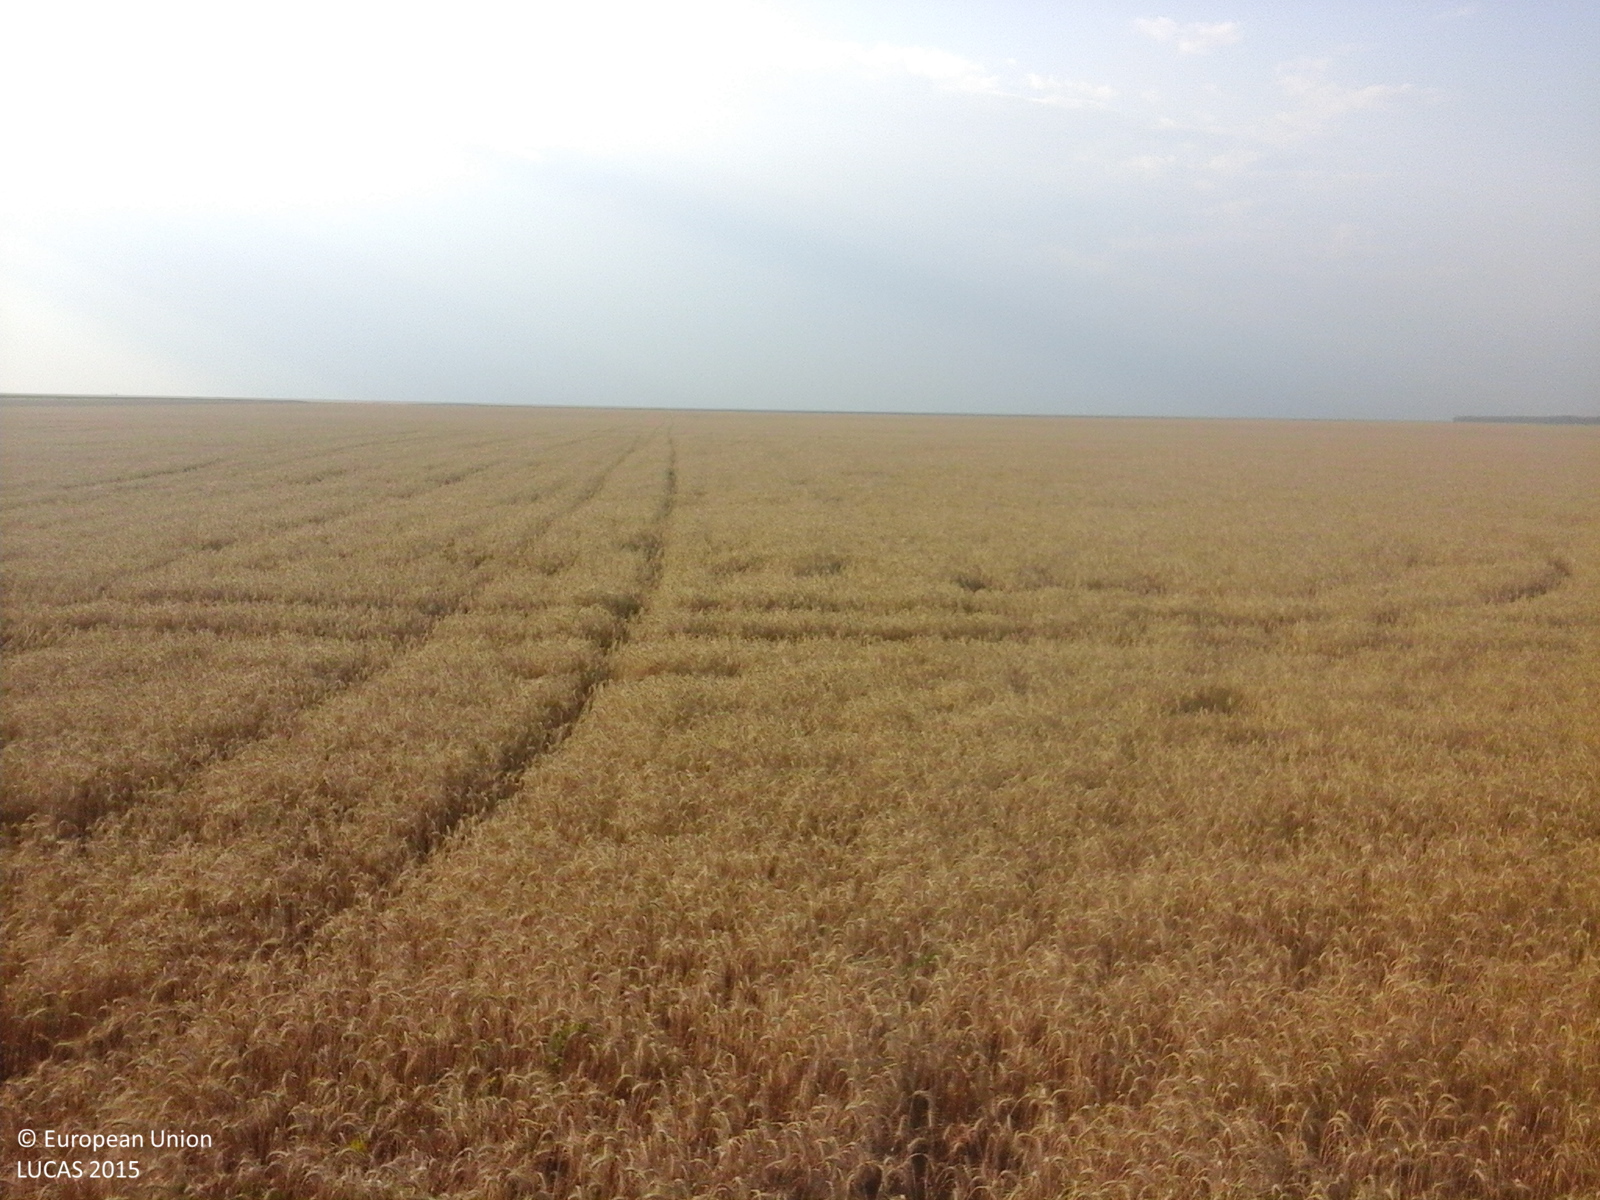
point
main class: Cropland
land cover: Common wheat
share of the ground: > 75 %
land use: Agriculture (excluding fallow land and kitchen gardens)
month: July
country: RO
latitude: 43.9261
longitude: 24.7810
